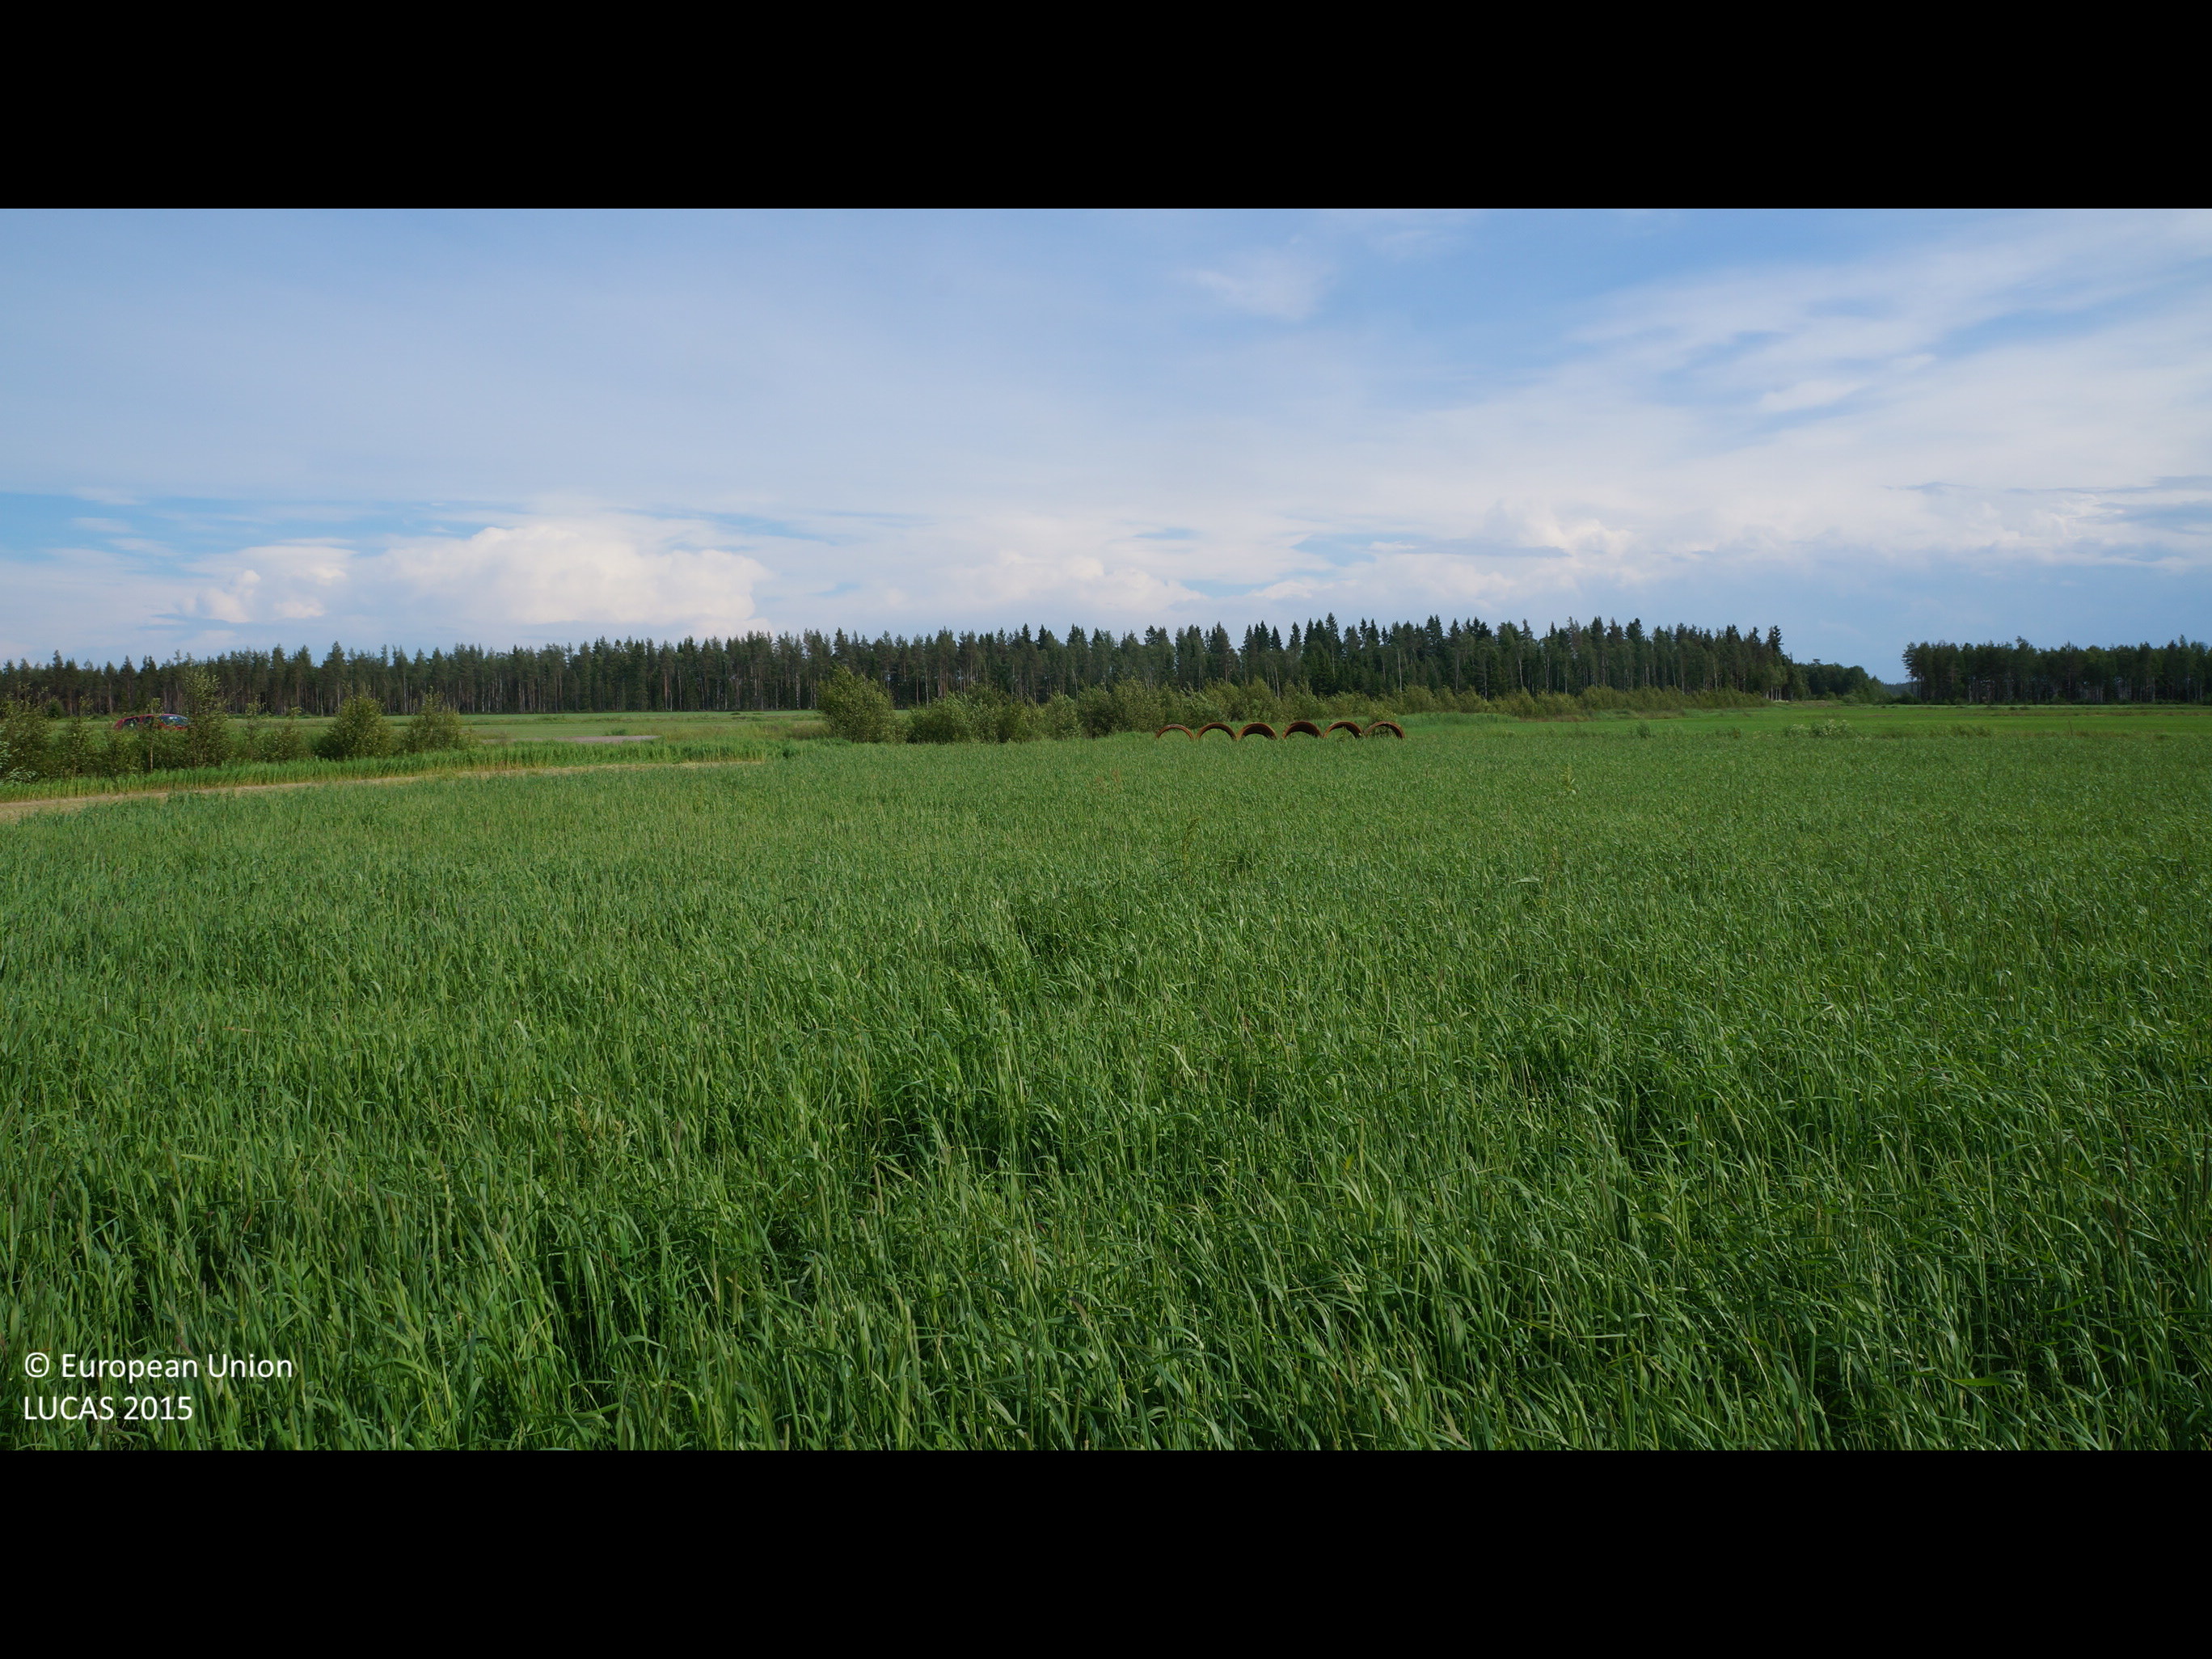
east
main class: Cropland
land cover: Temporary grasslands
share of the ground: > 75 %
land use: Agriculture (excluding fallow land and kitchen gardens)
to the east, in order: Temporary grasslands; Shruby margins; Ditches and canals; Grass margins; Tracks; Shruby margins; Ditches and canals; Barley; Ditches and canals; Barley
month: June
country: FI
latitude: 64.1861
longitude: 23.9142
